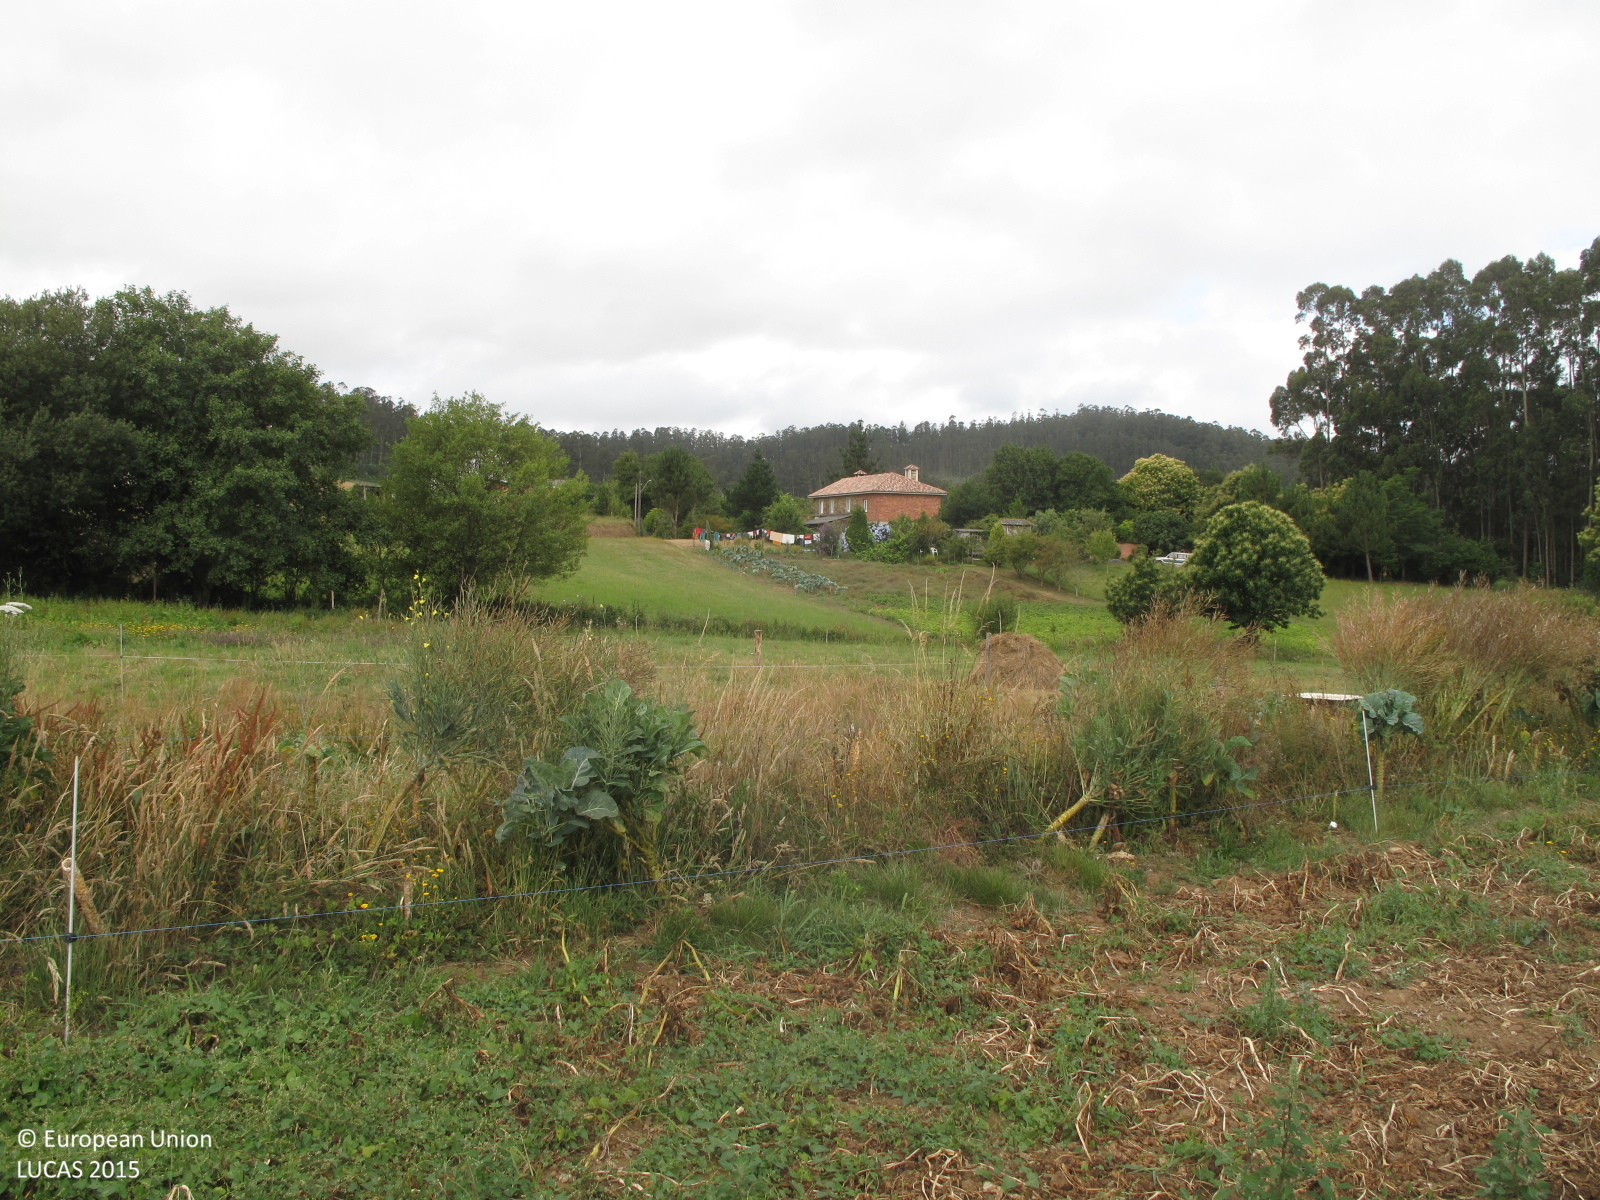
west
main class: Cropland
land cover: Potatoes
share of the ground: 25 - 50 %
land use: Kitchen garden
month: July
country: ES
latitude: 43.5960
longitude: -8.0732
